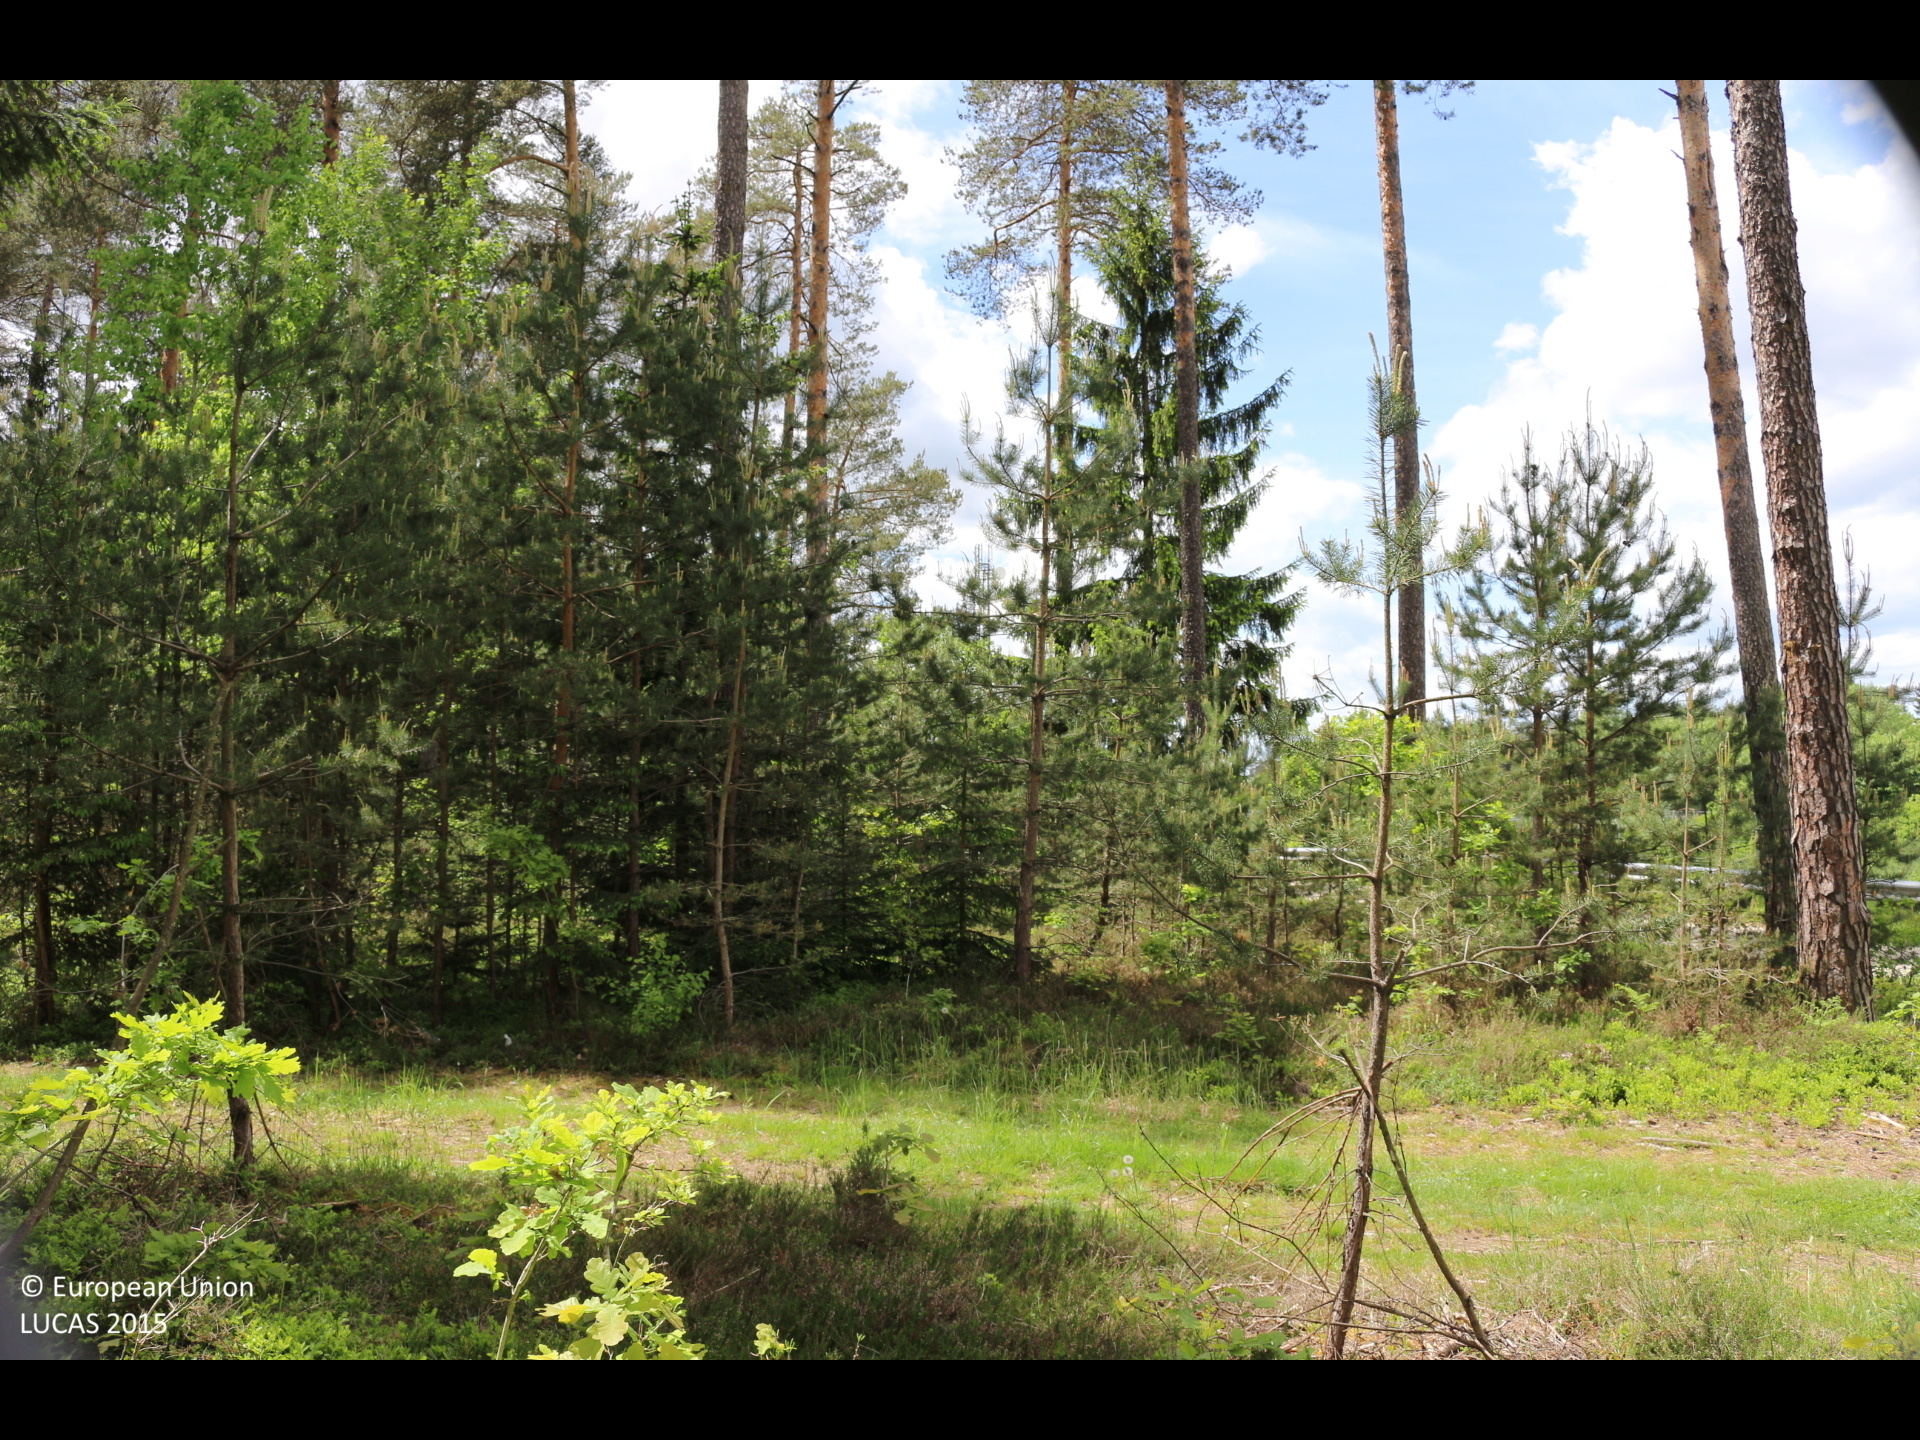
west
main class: Woodland
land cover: Other coniferous woodland
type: alpine coniferous forest
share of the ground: > 75 %
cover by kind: coniferous forest trees 90 %, shrubs 10 %
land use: Forestry
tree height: > 5 m
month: May
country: AT
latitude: 46.6373
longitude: 14.4521
